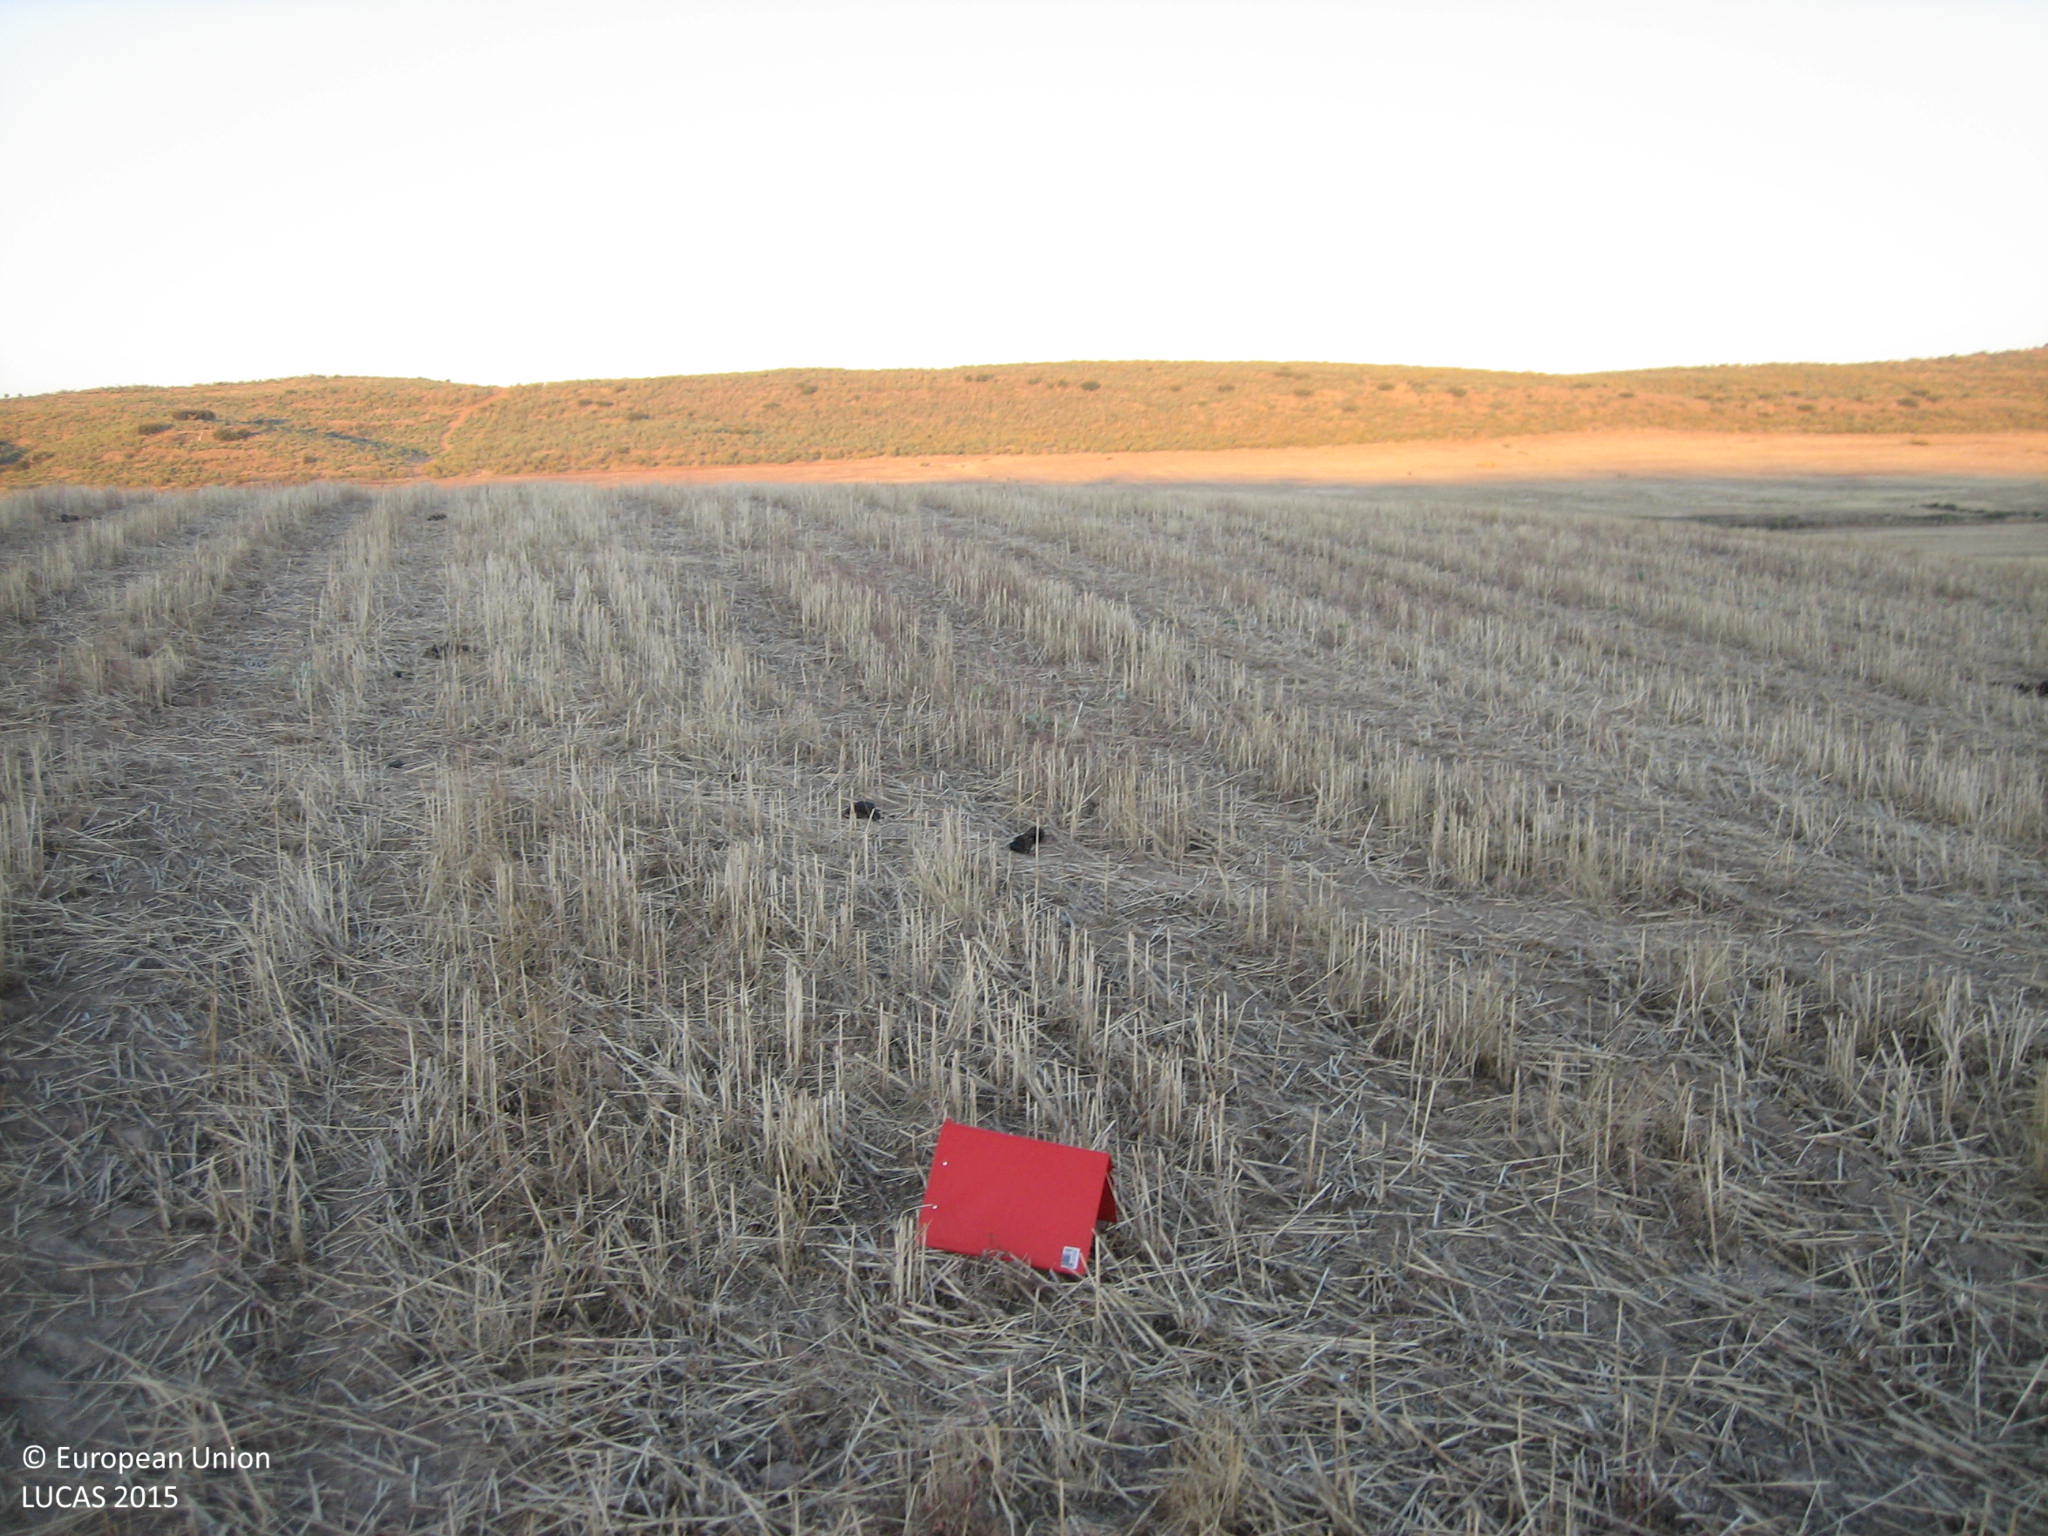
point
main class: Cropland
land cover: Common wheat
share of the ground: < 10 %
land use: Agriculture (excluding fallow land and kitchen gardens)
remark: Harvested field
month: July
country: ES
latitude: 38.2649
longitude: -6.0997
